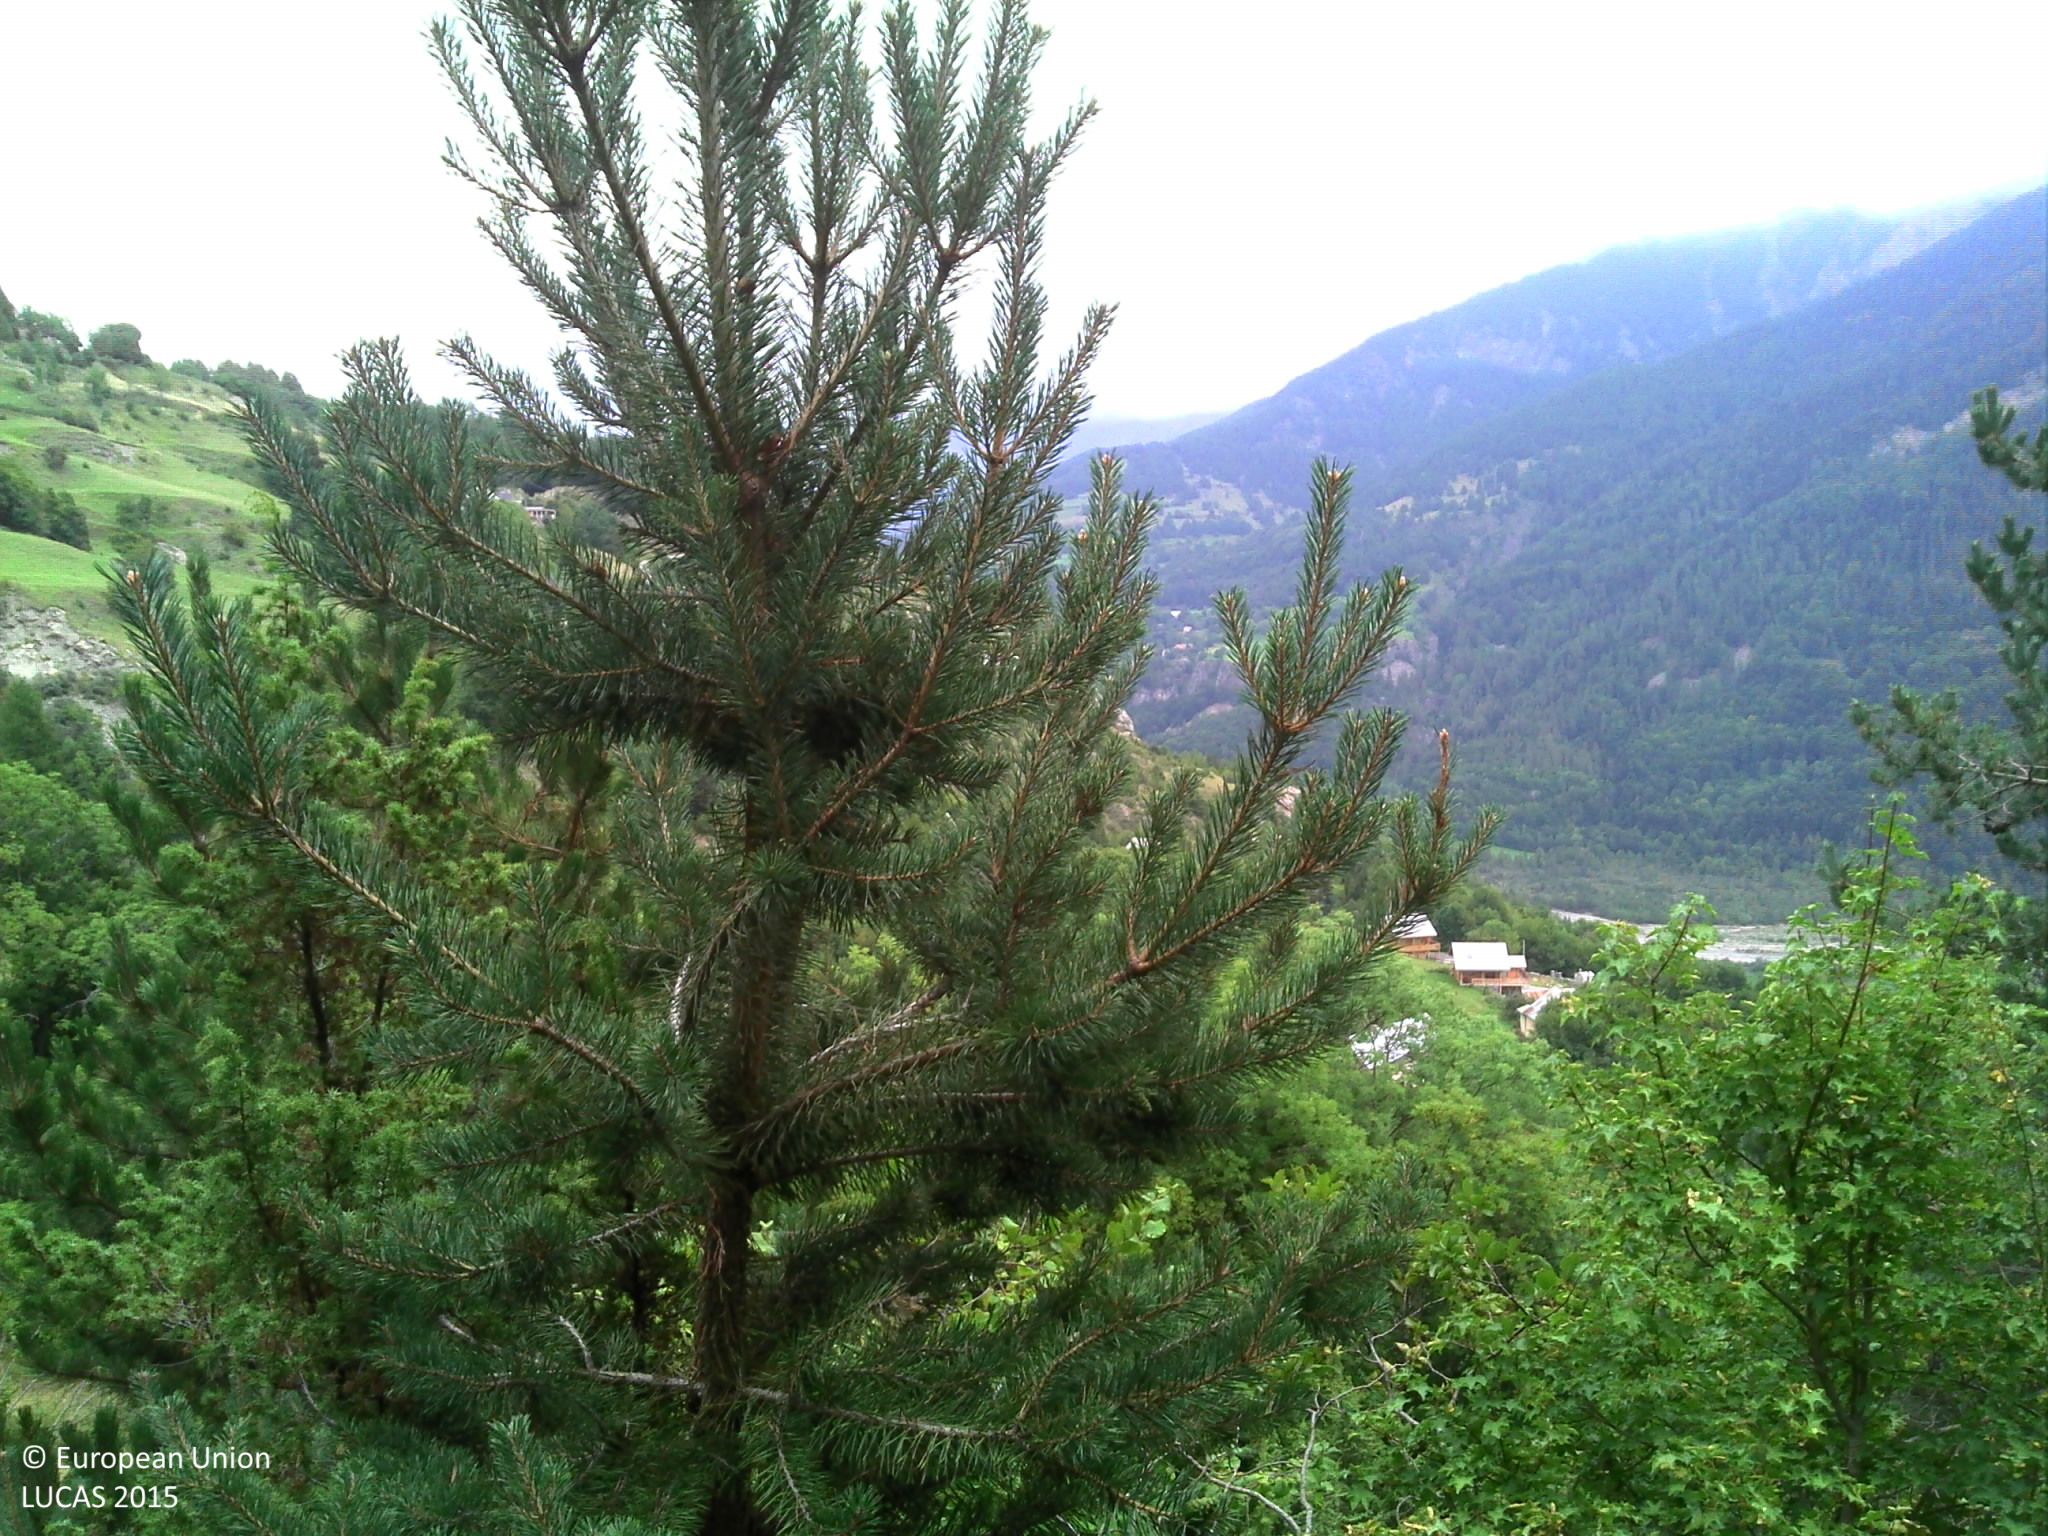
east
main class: Woodland
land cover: Other mixed woodland
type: hemiboreal forest and nemoral coniferous forest and mixed broadleaved-coniferous forest
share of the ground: > 75 %
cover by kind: coniferous forest trees 60 %, broadleaved forest trees 25 %, shrubs 10 %, herbaceous plants 5 %
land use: Forestry
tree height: > 5 m
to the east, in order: Other mixed woodland; Grassland with sparse tree/shrub cover; Broadleaved woodland; Grassland with sparse tree/shrub cover; Broadleaved woodland; Fences; Broadleaved woodland; Grassland with sparse tree/shrub cover; Fences; Broadleaved woodland; Fences; Broadleaved woodland
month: September
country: FR
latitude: 44.6794
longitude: 6.2342
